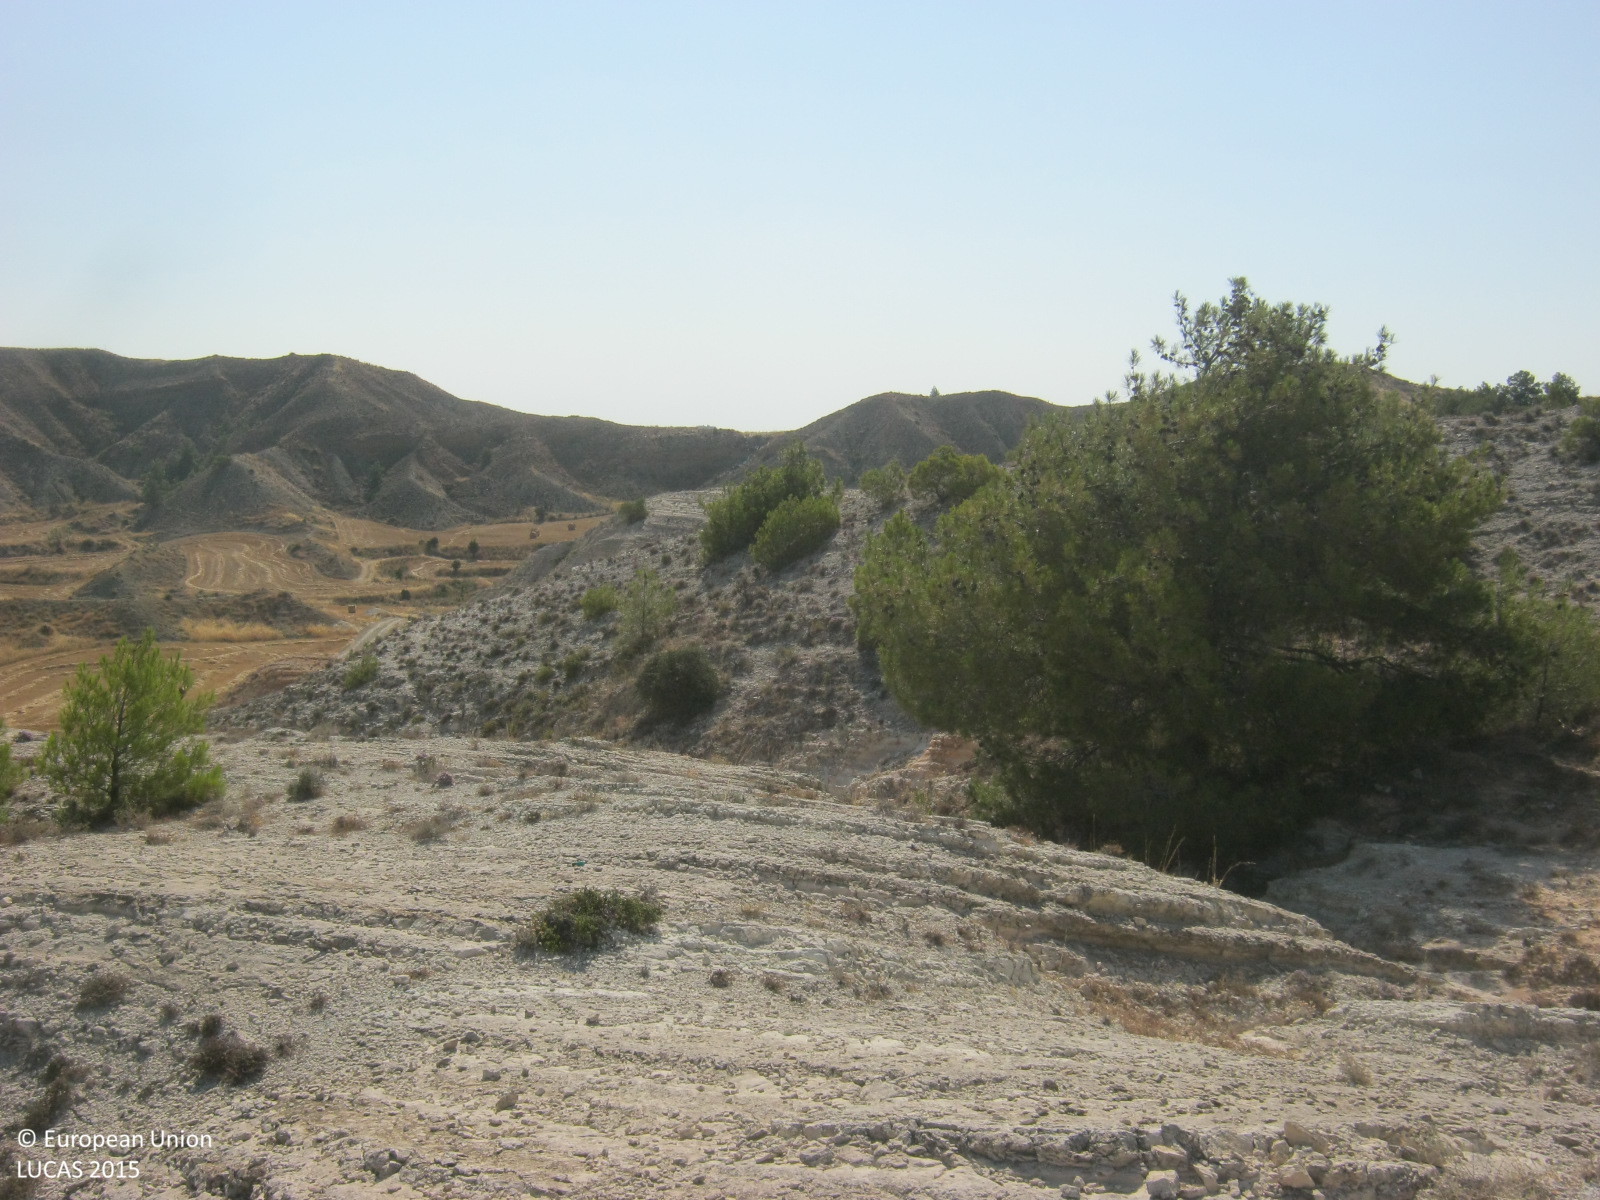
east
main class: Shrubland
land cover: Shrubland without tree cover
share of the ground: 10 - 25 %
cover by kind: unconsolidated bare surface 60 %, shrubs 20 %, herbaceous plants 20 %
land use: Semi-natural and natural areas not in use
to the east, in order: Shrubland without tree cover; Rocks and stones; Rivers and streams; Shrubland with sparse tree cover; Shrubland without tree cover; Shrubland with sparse tree cover; Rocks and stones; Rivers and streams; Rocks and stones; Shrubland with sparse tree cover; Rocks and stones
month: June
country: CY
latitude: 35.0390
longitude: 33.2147
